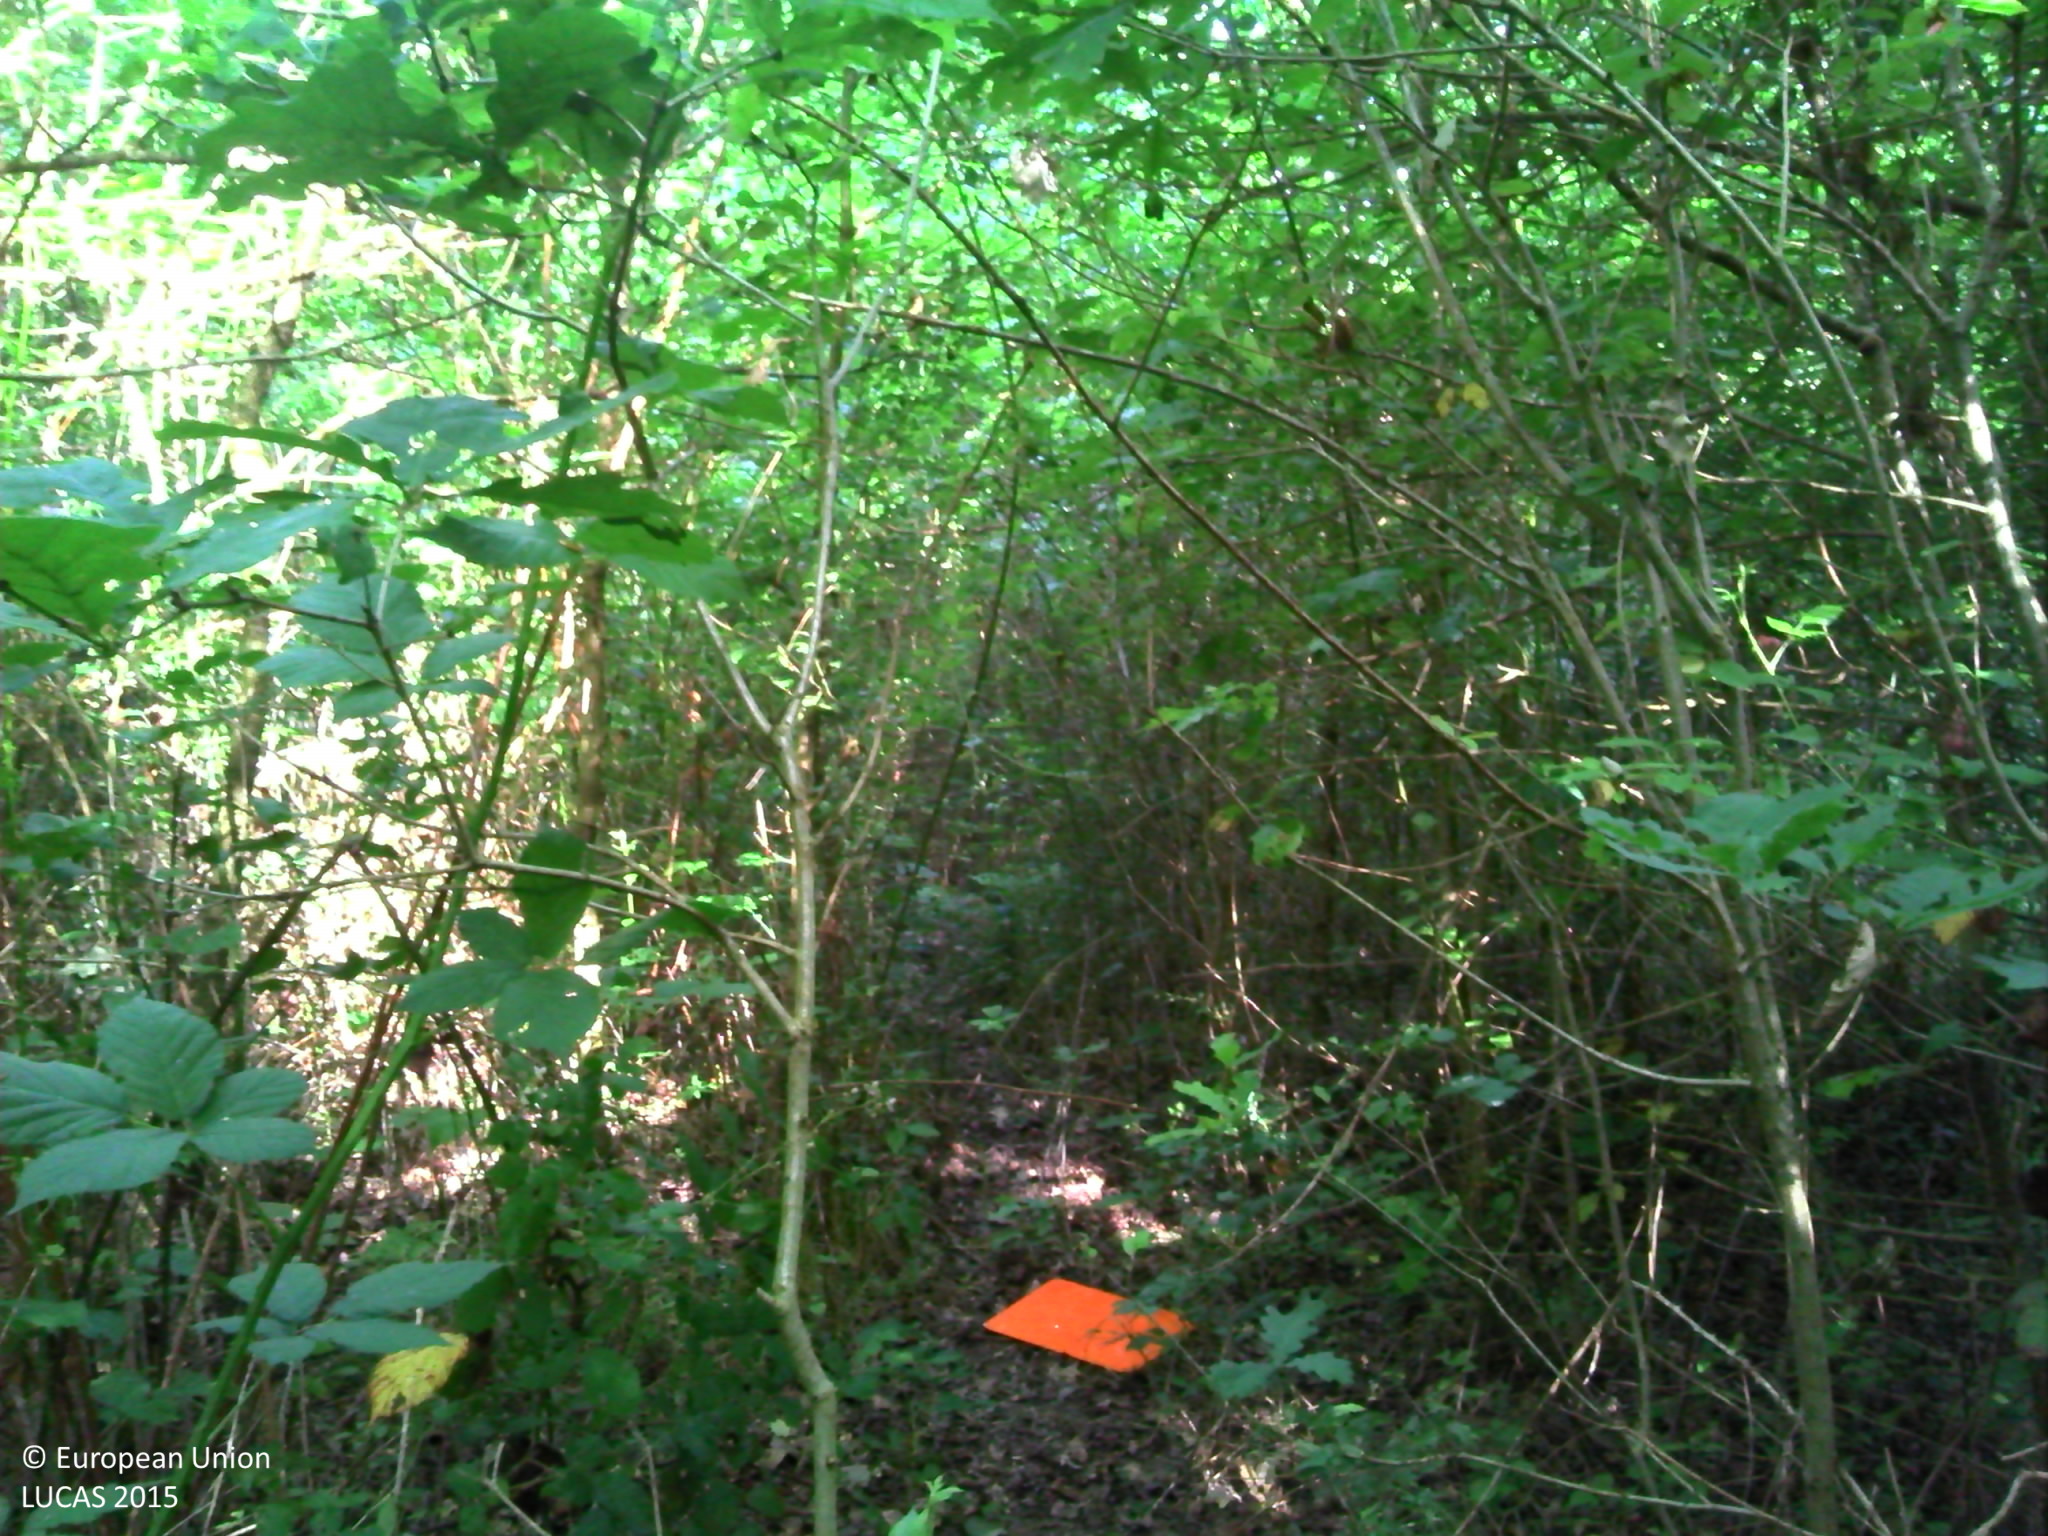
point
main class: Woodland
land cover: Broadleaved woodland
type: mesophytic deciduous forest
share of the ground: > 75 %
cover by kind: broadleaved forest trees 85 %, shrubs 10 %, herbaceous plants 5 %
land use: Semi-natural and natural areas not in use
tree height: > 5 m
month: June
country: FR
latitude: 47.2711
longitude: -1.5285
